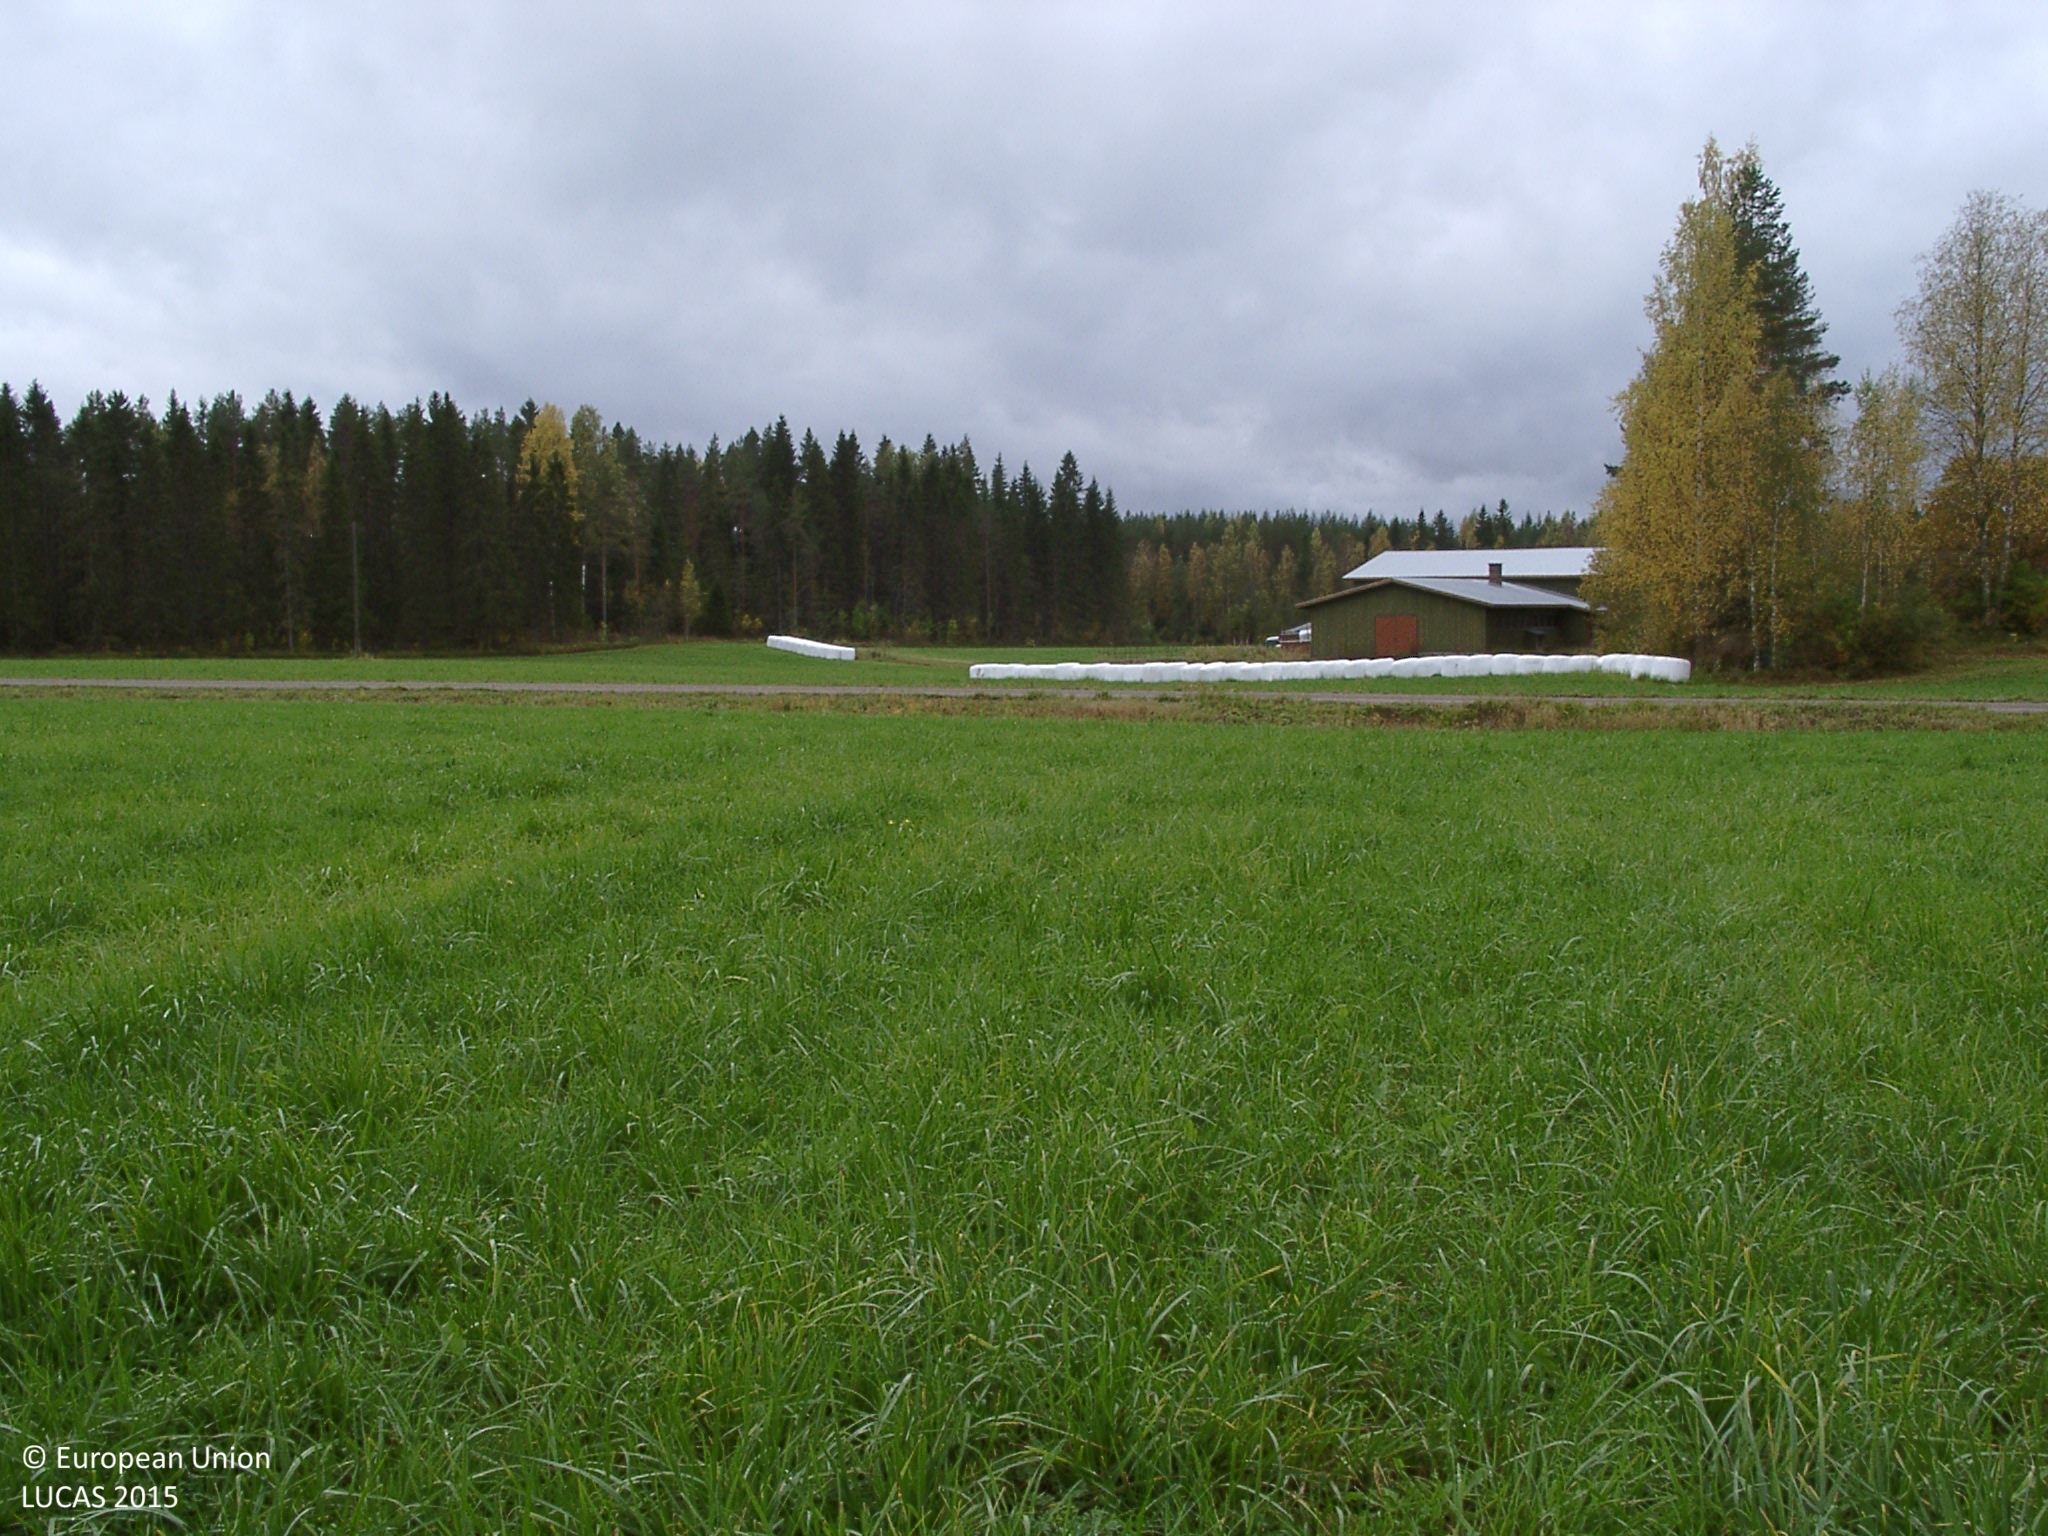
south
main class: Cropland
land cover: Other leguminous and mixtures for fodder
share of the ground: > 75 %
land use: Agriculture (excluding fallow land and kitchen gardens)
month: September
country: FI
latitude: 62.7888
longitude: 25.4163
